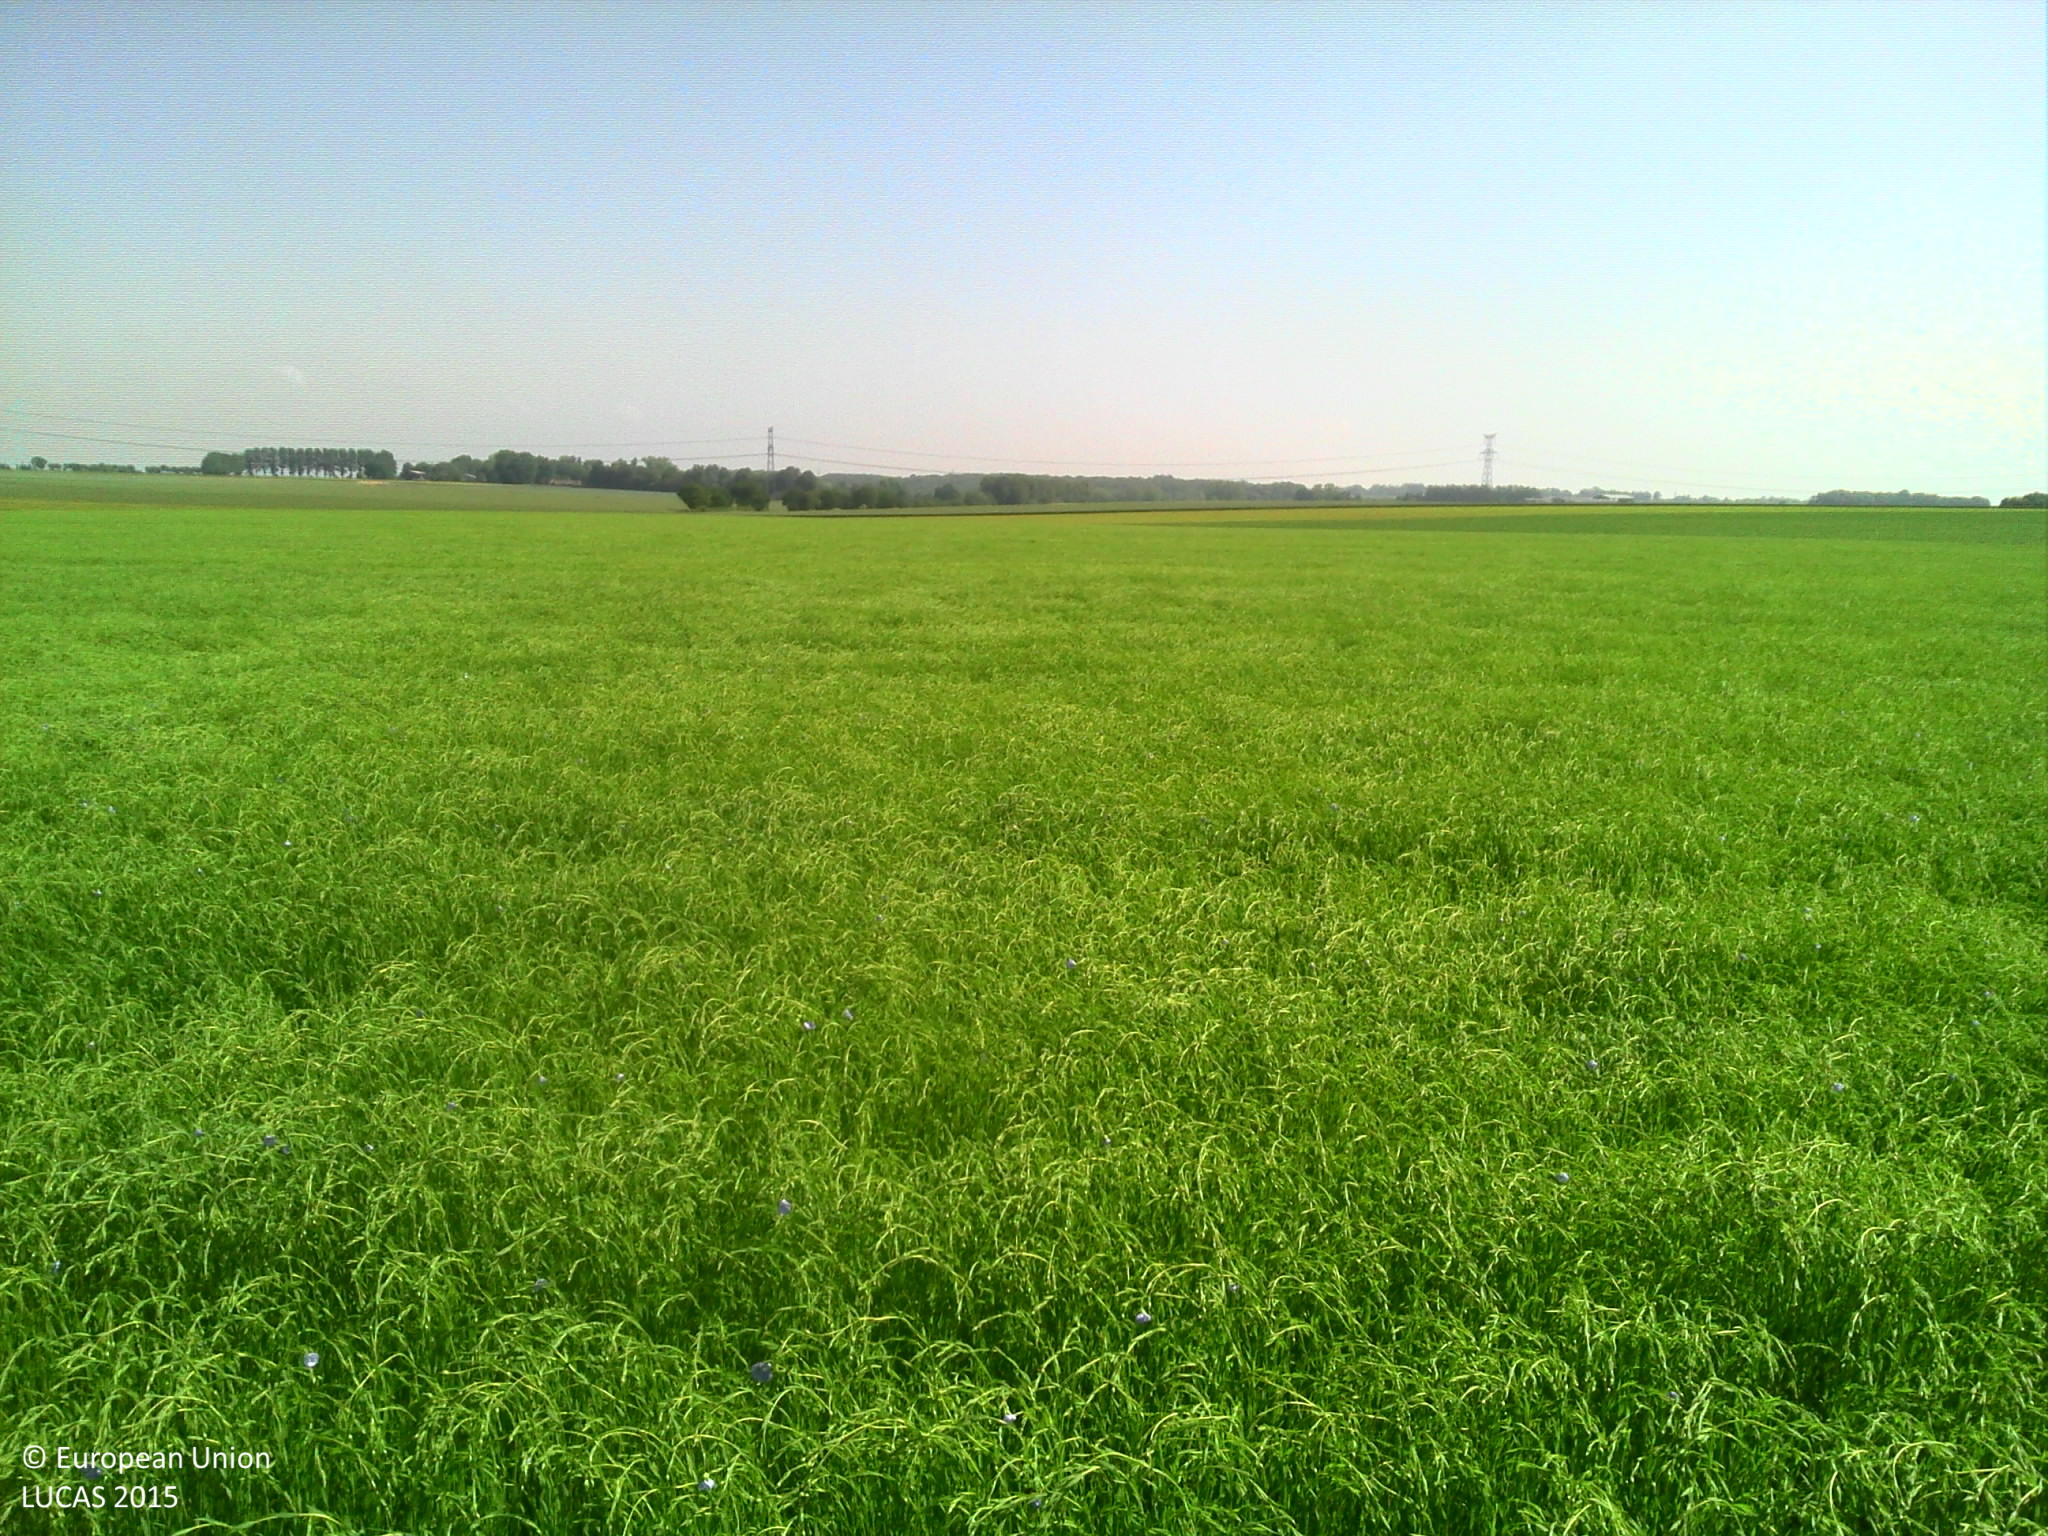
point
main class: Cropland
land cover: Other fibre and oleaginous crops
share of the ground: > 75 %
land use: Agriculture (excluding fallow land and kitchen gardens)
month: June
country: FR
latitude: 50.0262
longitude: 1.7050
